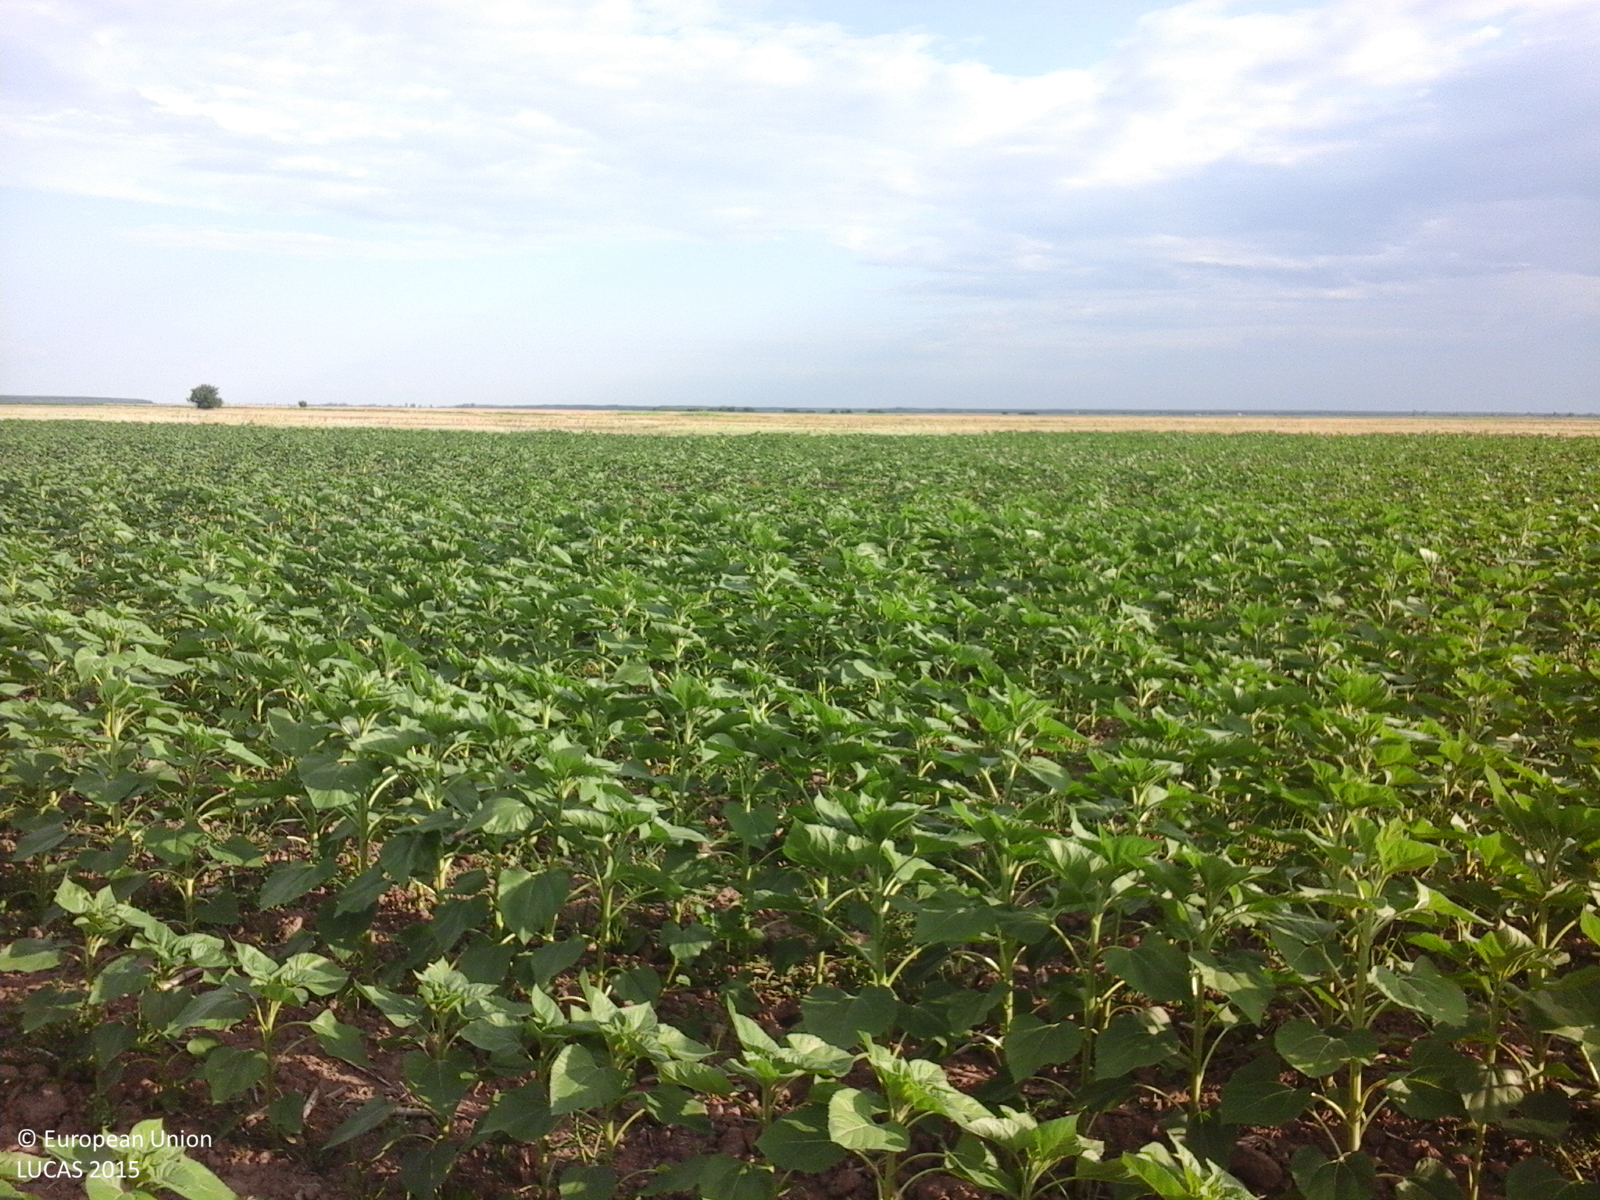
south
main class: Cropland
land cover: Sunflower
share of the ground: 50 - 75 %
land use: Agriculture (excluding fallow land and kitchen gardens)
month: July
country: RO
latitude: 44.3999
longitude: 25.4193
